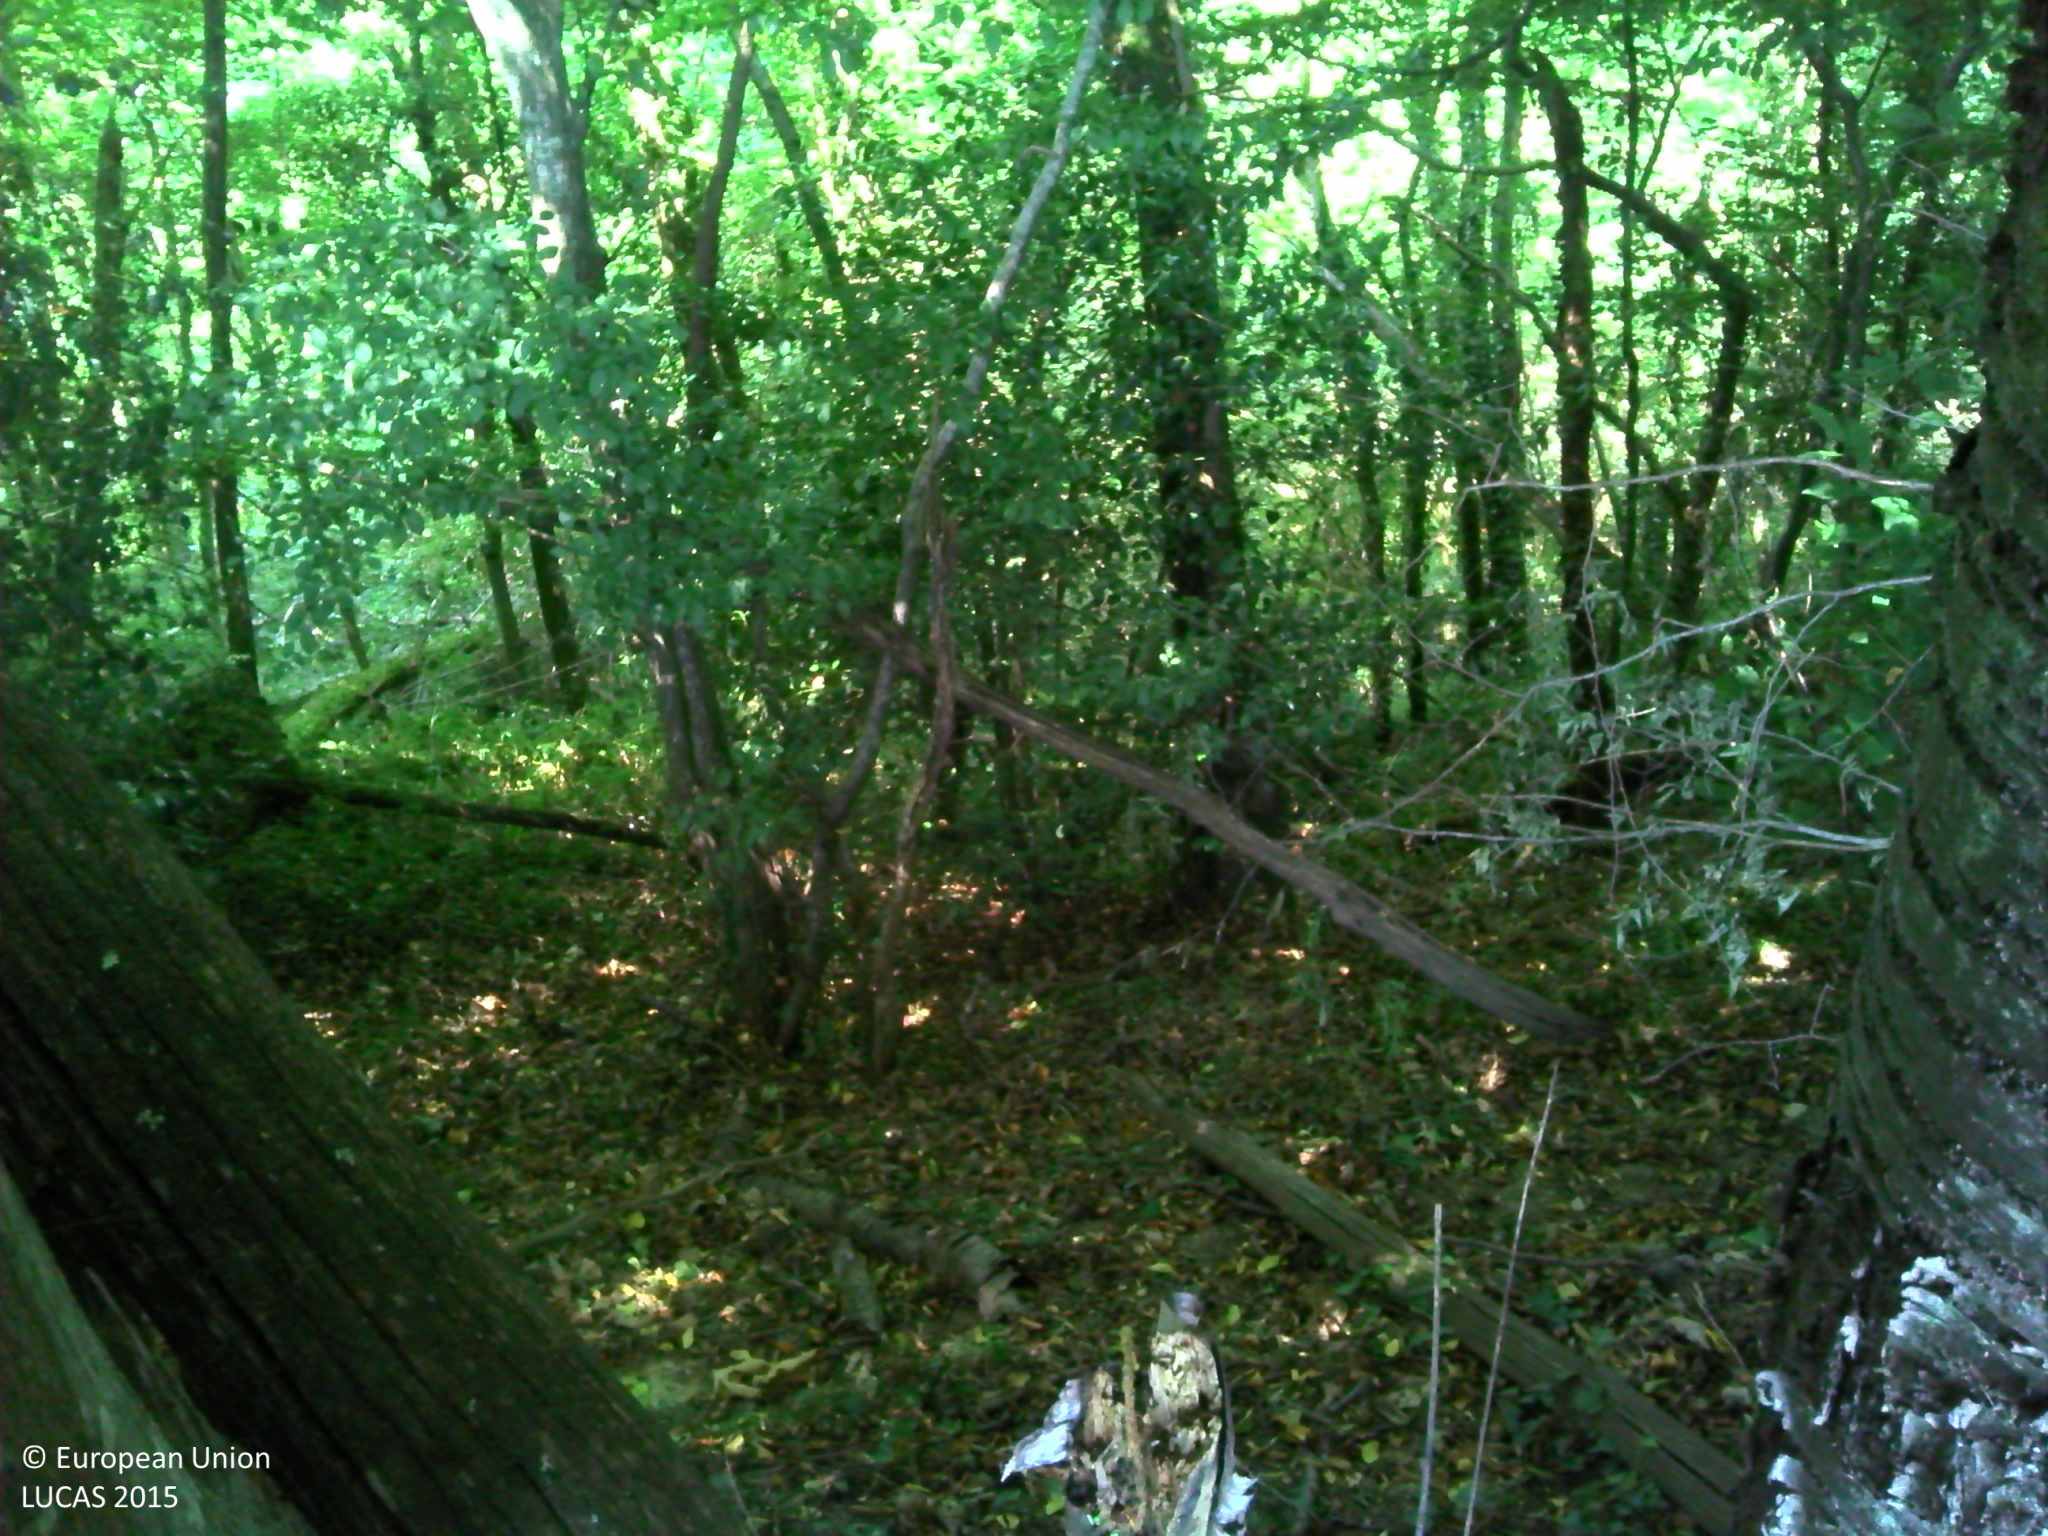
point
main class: Woodland
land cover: Broadleaved woodland
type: thermophilous deciduous forest
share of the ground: > 75 %
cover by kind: broadleaved forest trees 90 %, herbaceous plants 10 %
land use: Semi-natural and natural areas not in use
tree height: > 5 m
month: July
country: FR
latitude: 45.3733
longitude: 5.1142
